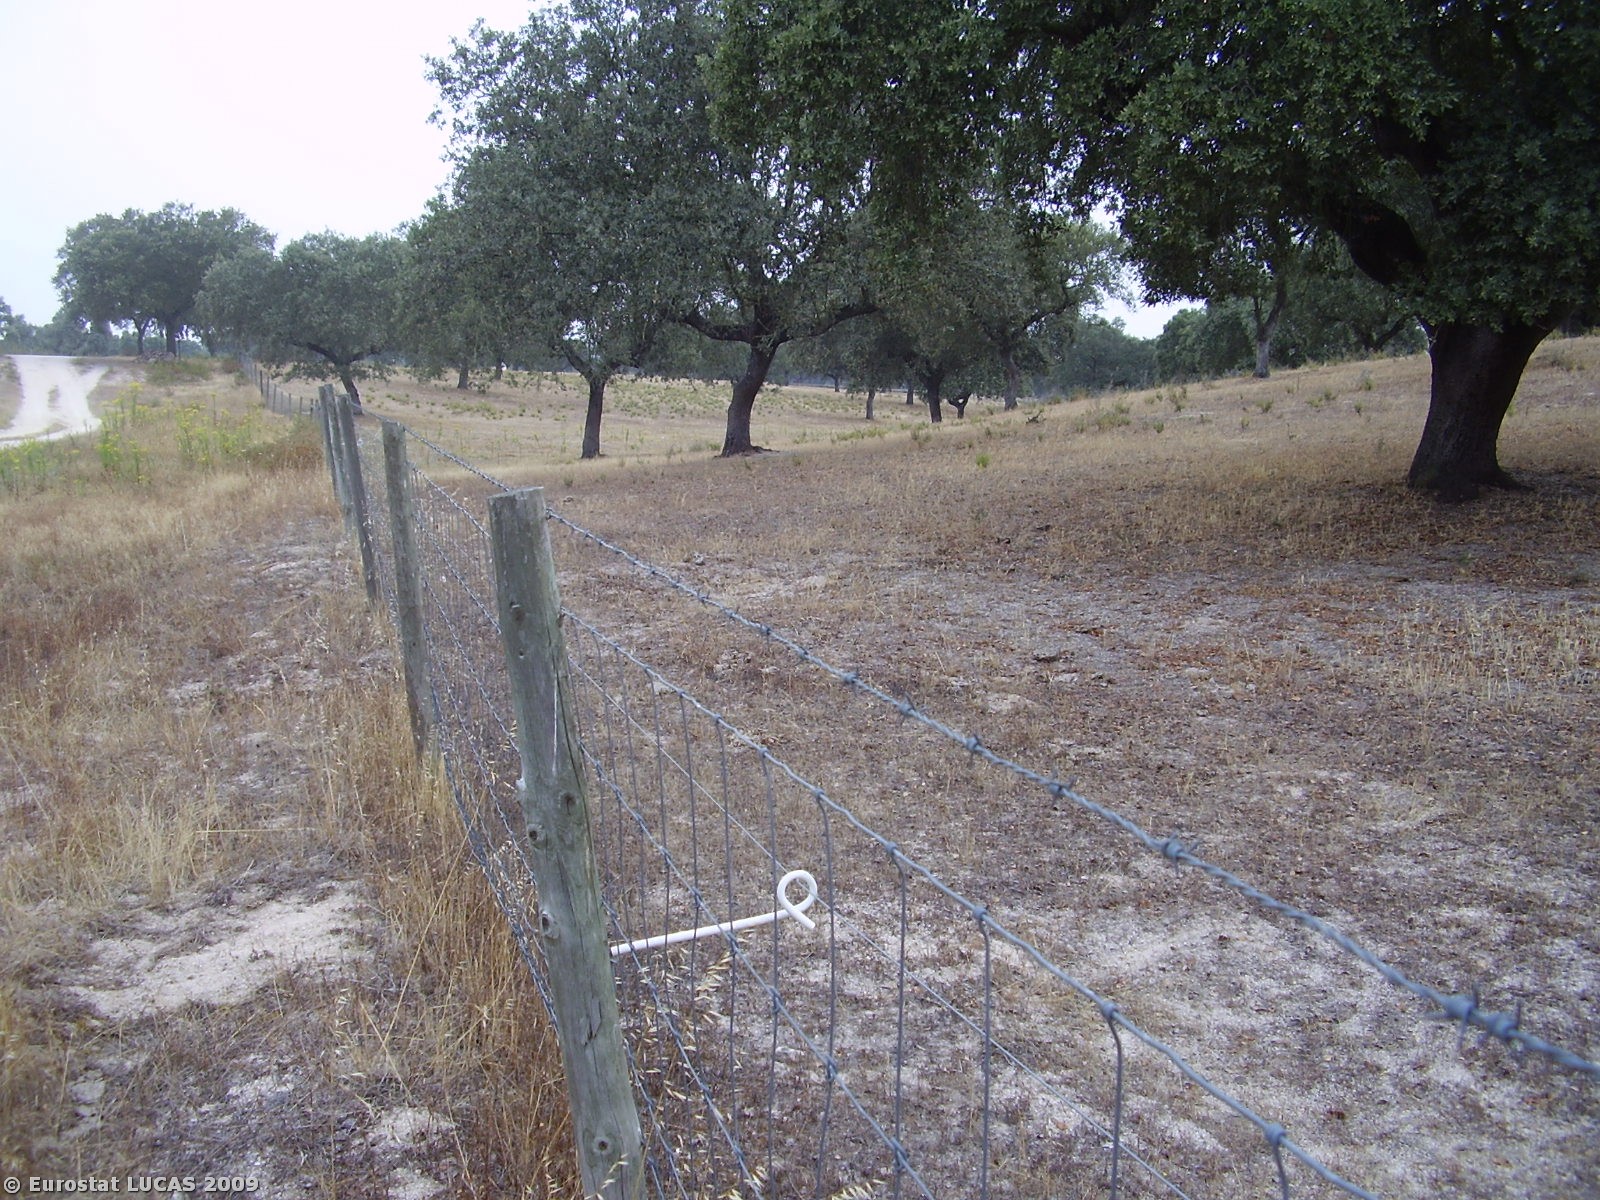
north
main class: Woodland
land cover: Broadleaved woodland
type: broadleaved evergreen forest
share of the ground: 10 - 25 %
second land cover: Spontaneously vegetated surfaces
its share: 50 - 75 %
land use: Forestry
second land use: Fallow land
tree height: > 5 m
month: July
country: PT
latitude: 38.8083
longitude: -7.9047
